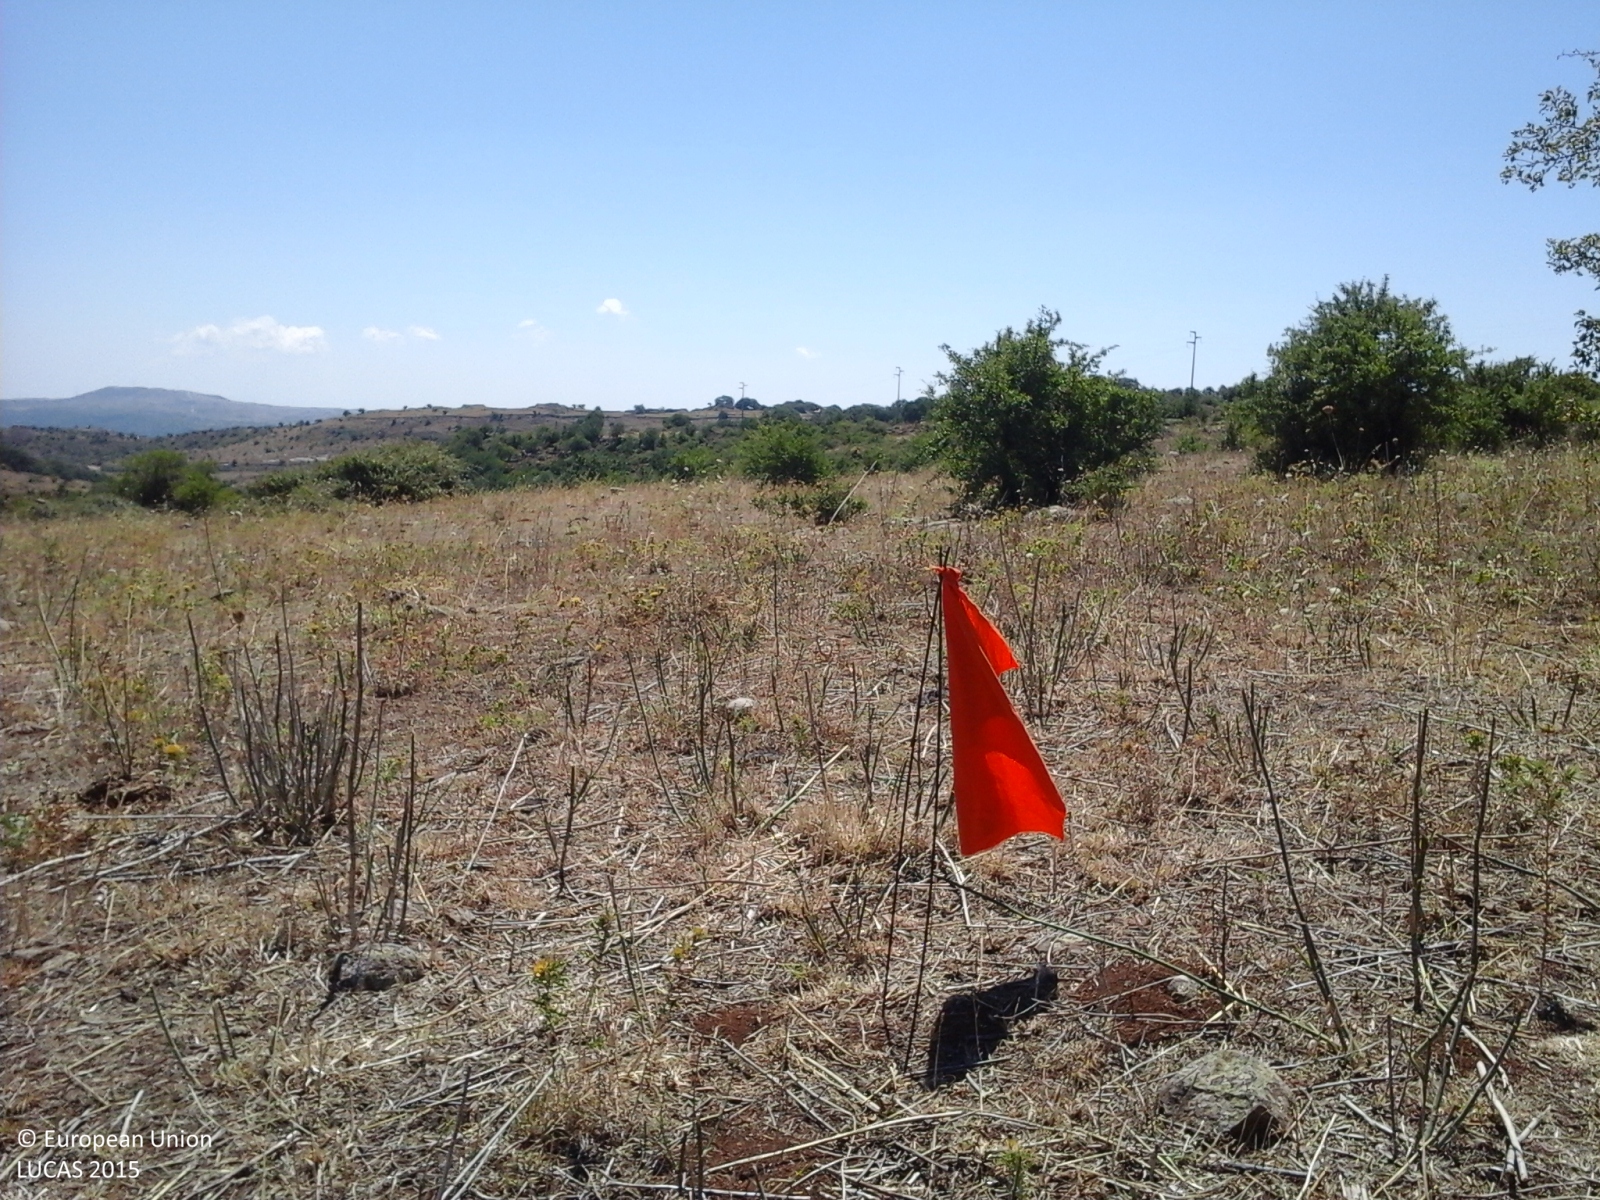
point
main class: Shrubland
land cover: Shrubland without tree cover
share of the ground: > 75 %
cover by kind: herbaceous plants 70 %, shrubs 30 %
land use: Agriculture (excluding fallow land and kitchen gardens)
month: July
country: IT
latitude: 37.1129
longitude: 14.8804
